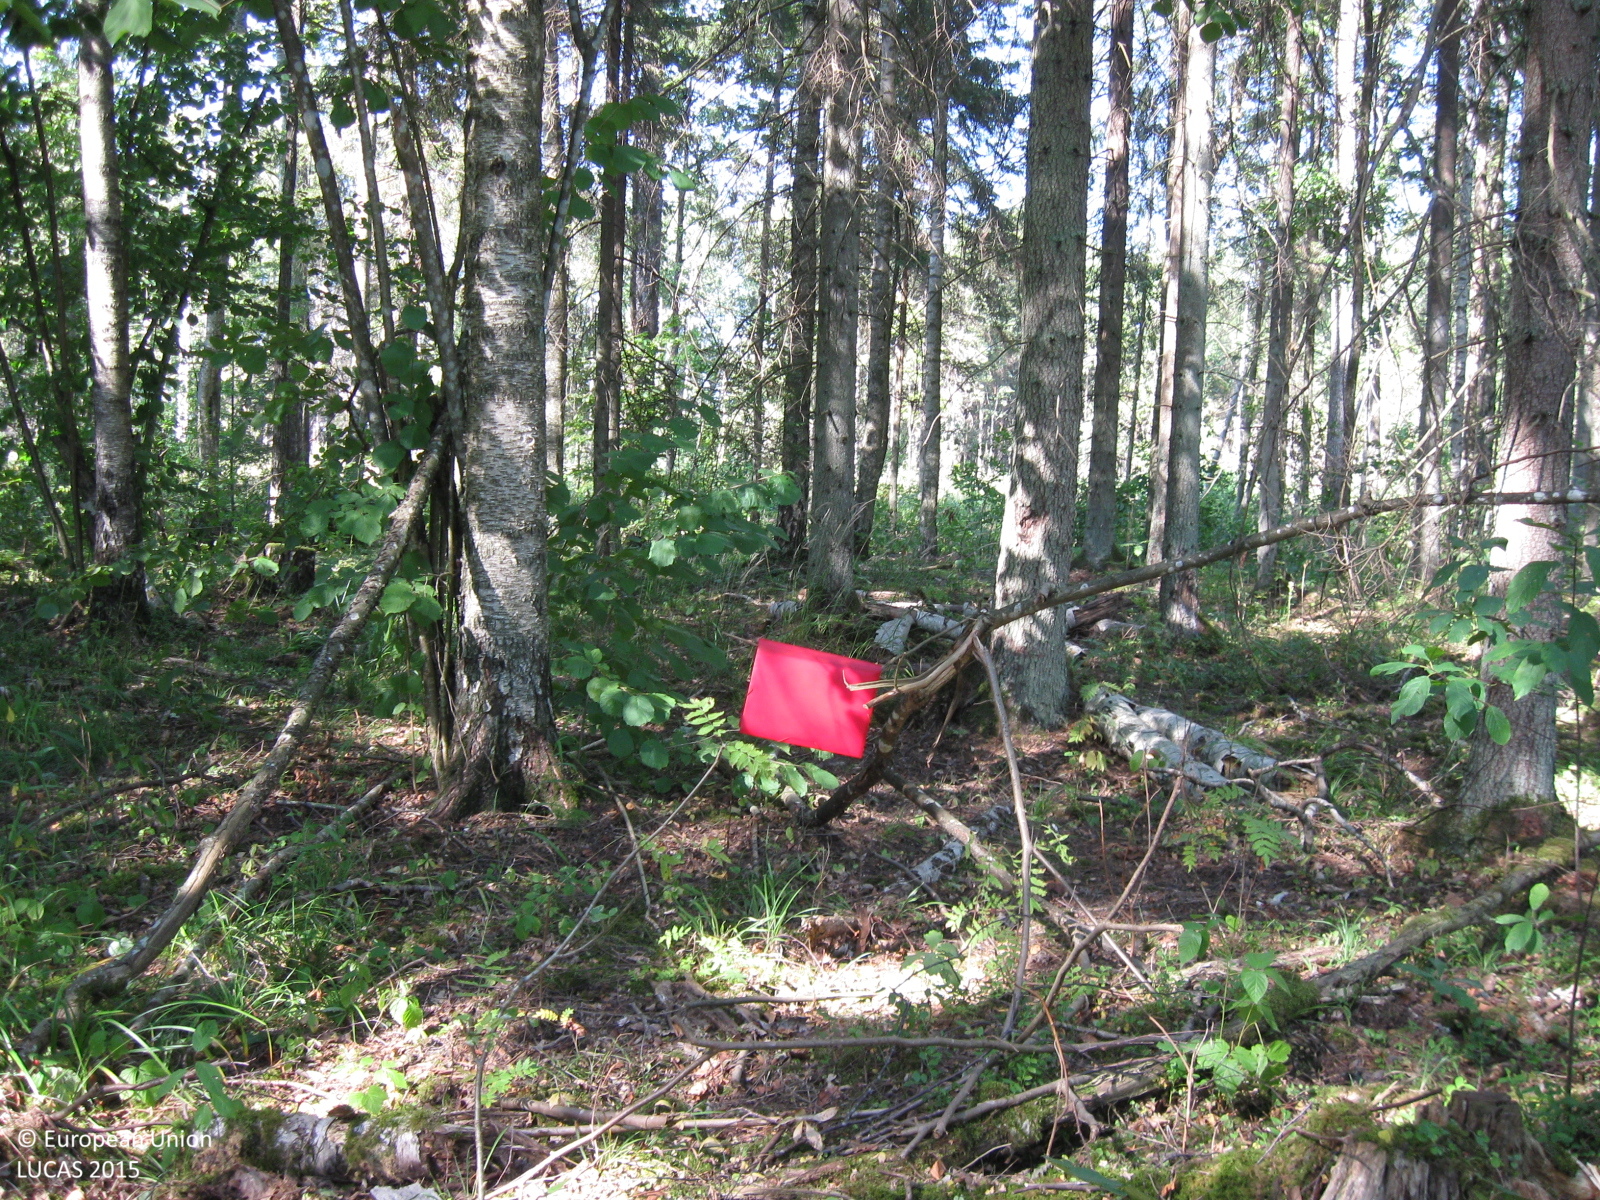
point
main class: Woodland
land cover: Spruce dominated mixed woodland
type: hemiboreal forest and nemoral coniferous forest and mixed broadleaved-coniferous forest
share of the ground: > 75 %
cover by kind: broadleaved forest trees 45 %, coniferous forest trees 40 %, herbaceous plants 10 %, lichens and mosses 5 %
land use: Forestry
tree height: > 5 m
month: August
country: LT
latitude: 55.3096
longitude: 22.5881
